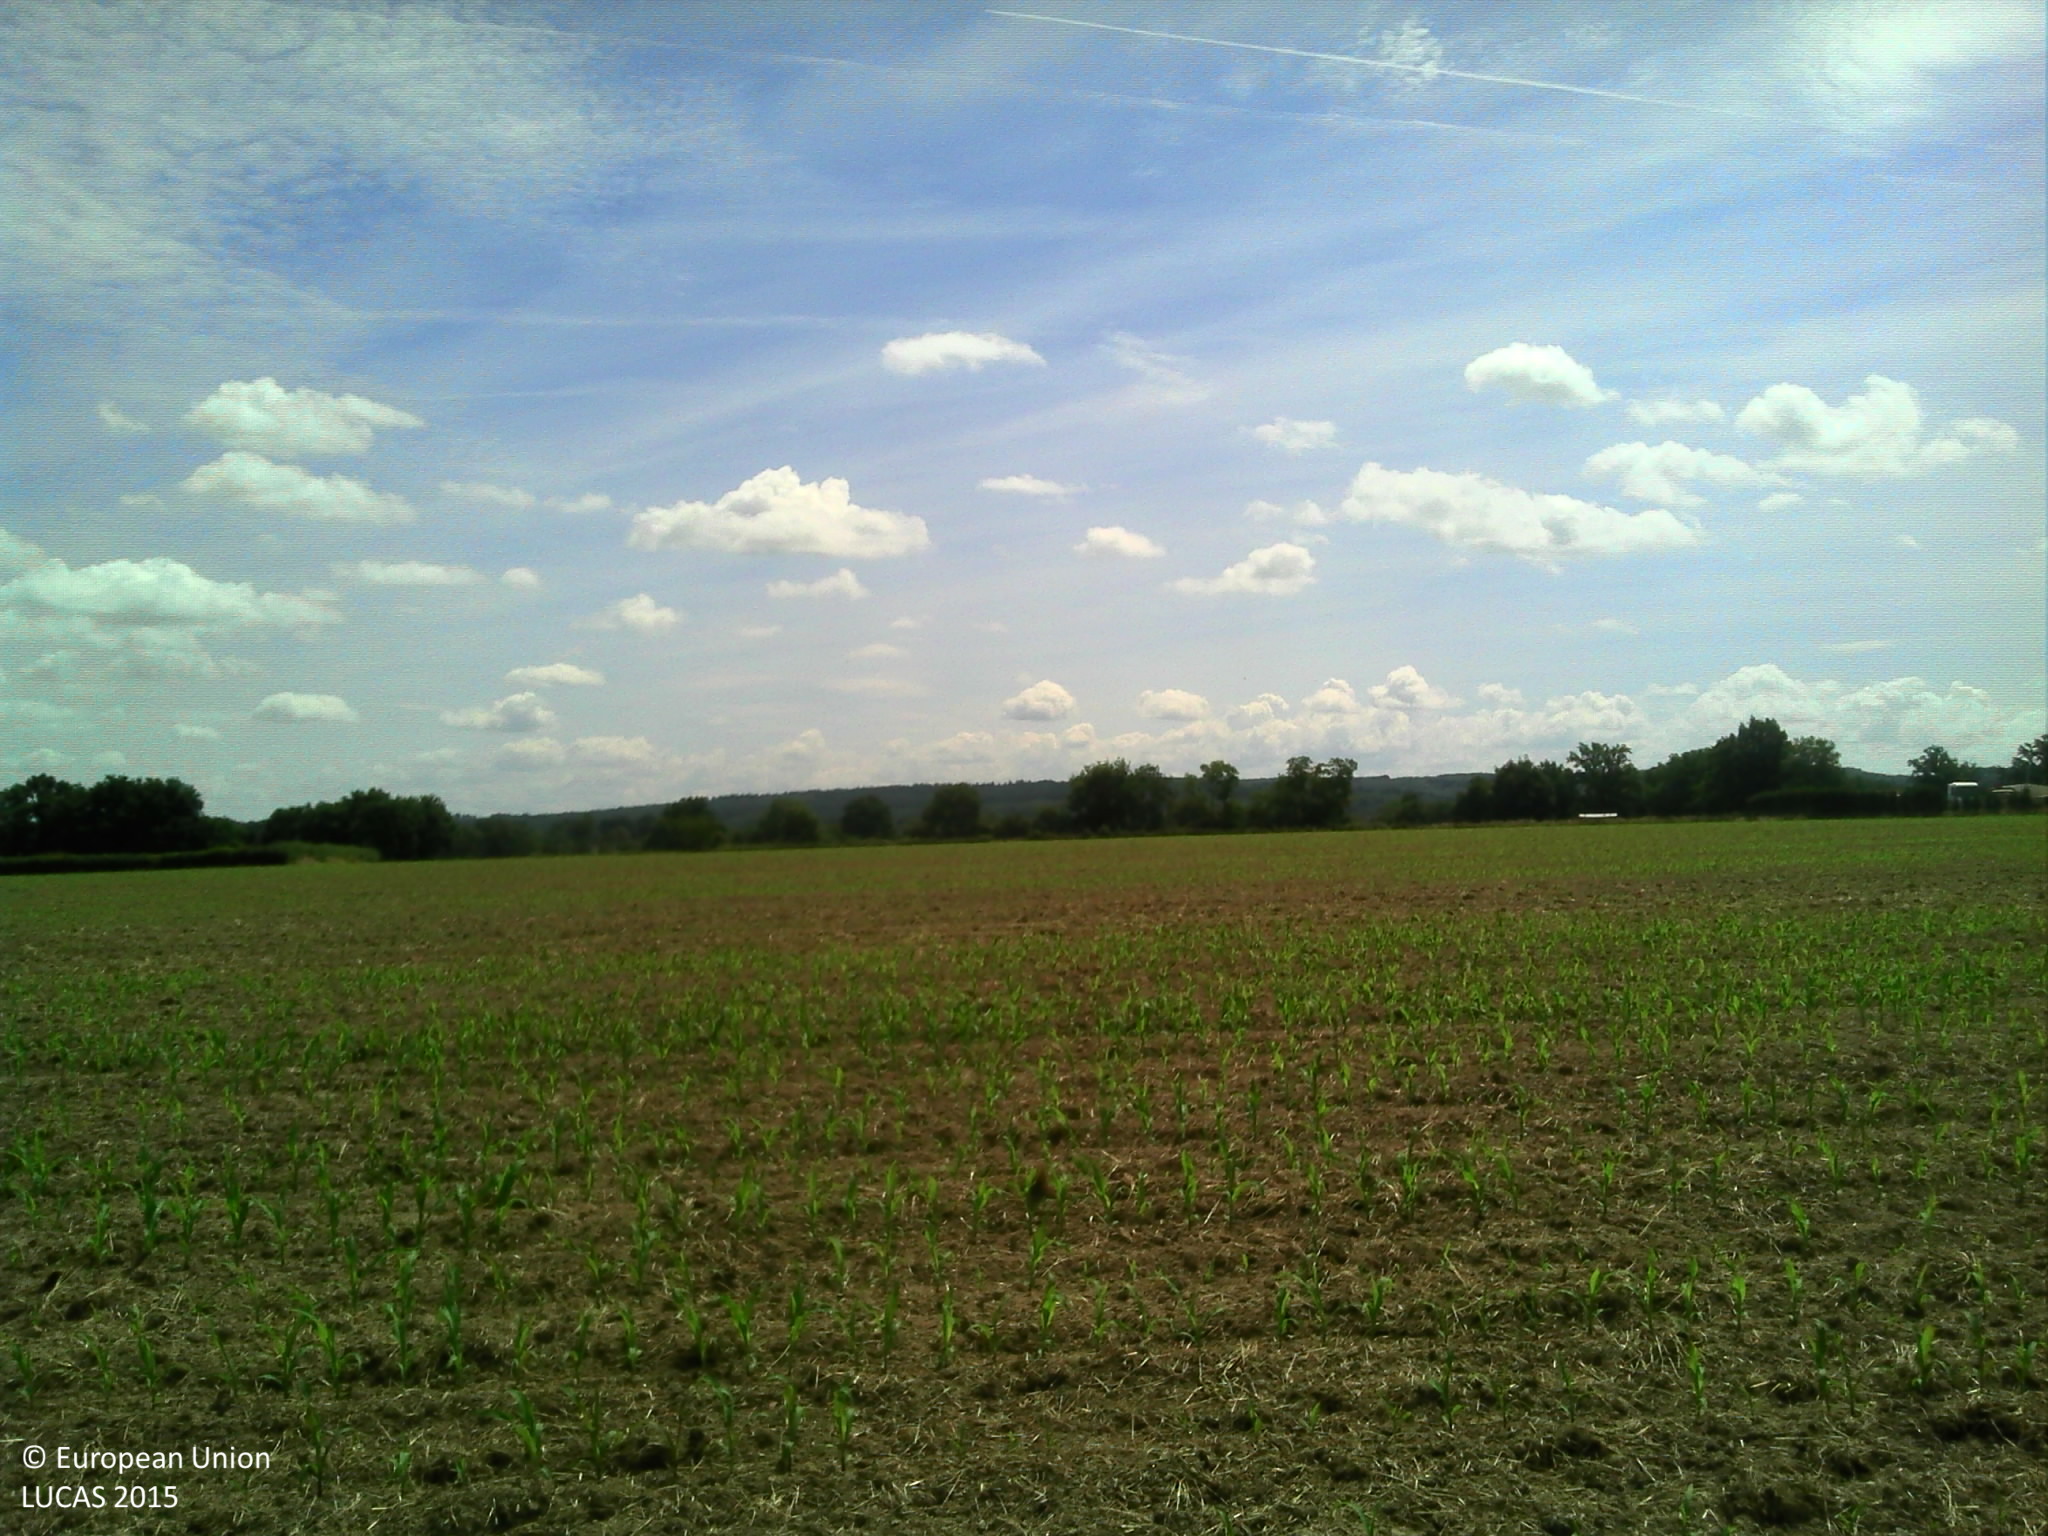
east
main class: Cropland
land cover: Maize
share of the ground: 10 - 25 %
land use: Agriculture (excluding fallow land and kitchen gardens)
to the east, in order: Maize
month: June
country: FR
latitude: 46.2935
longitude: 4.0425
